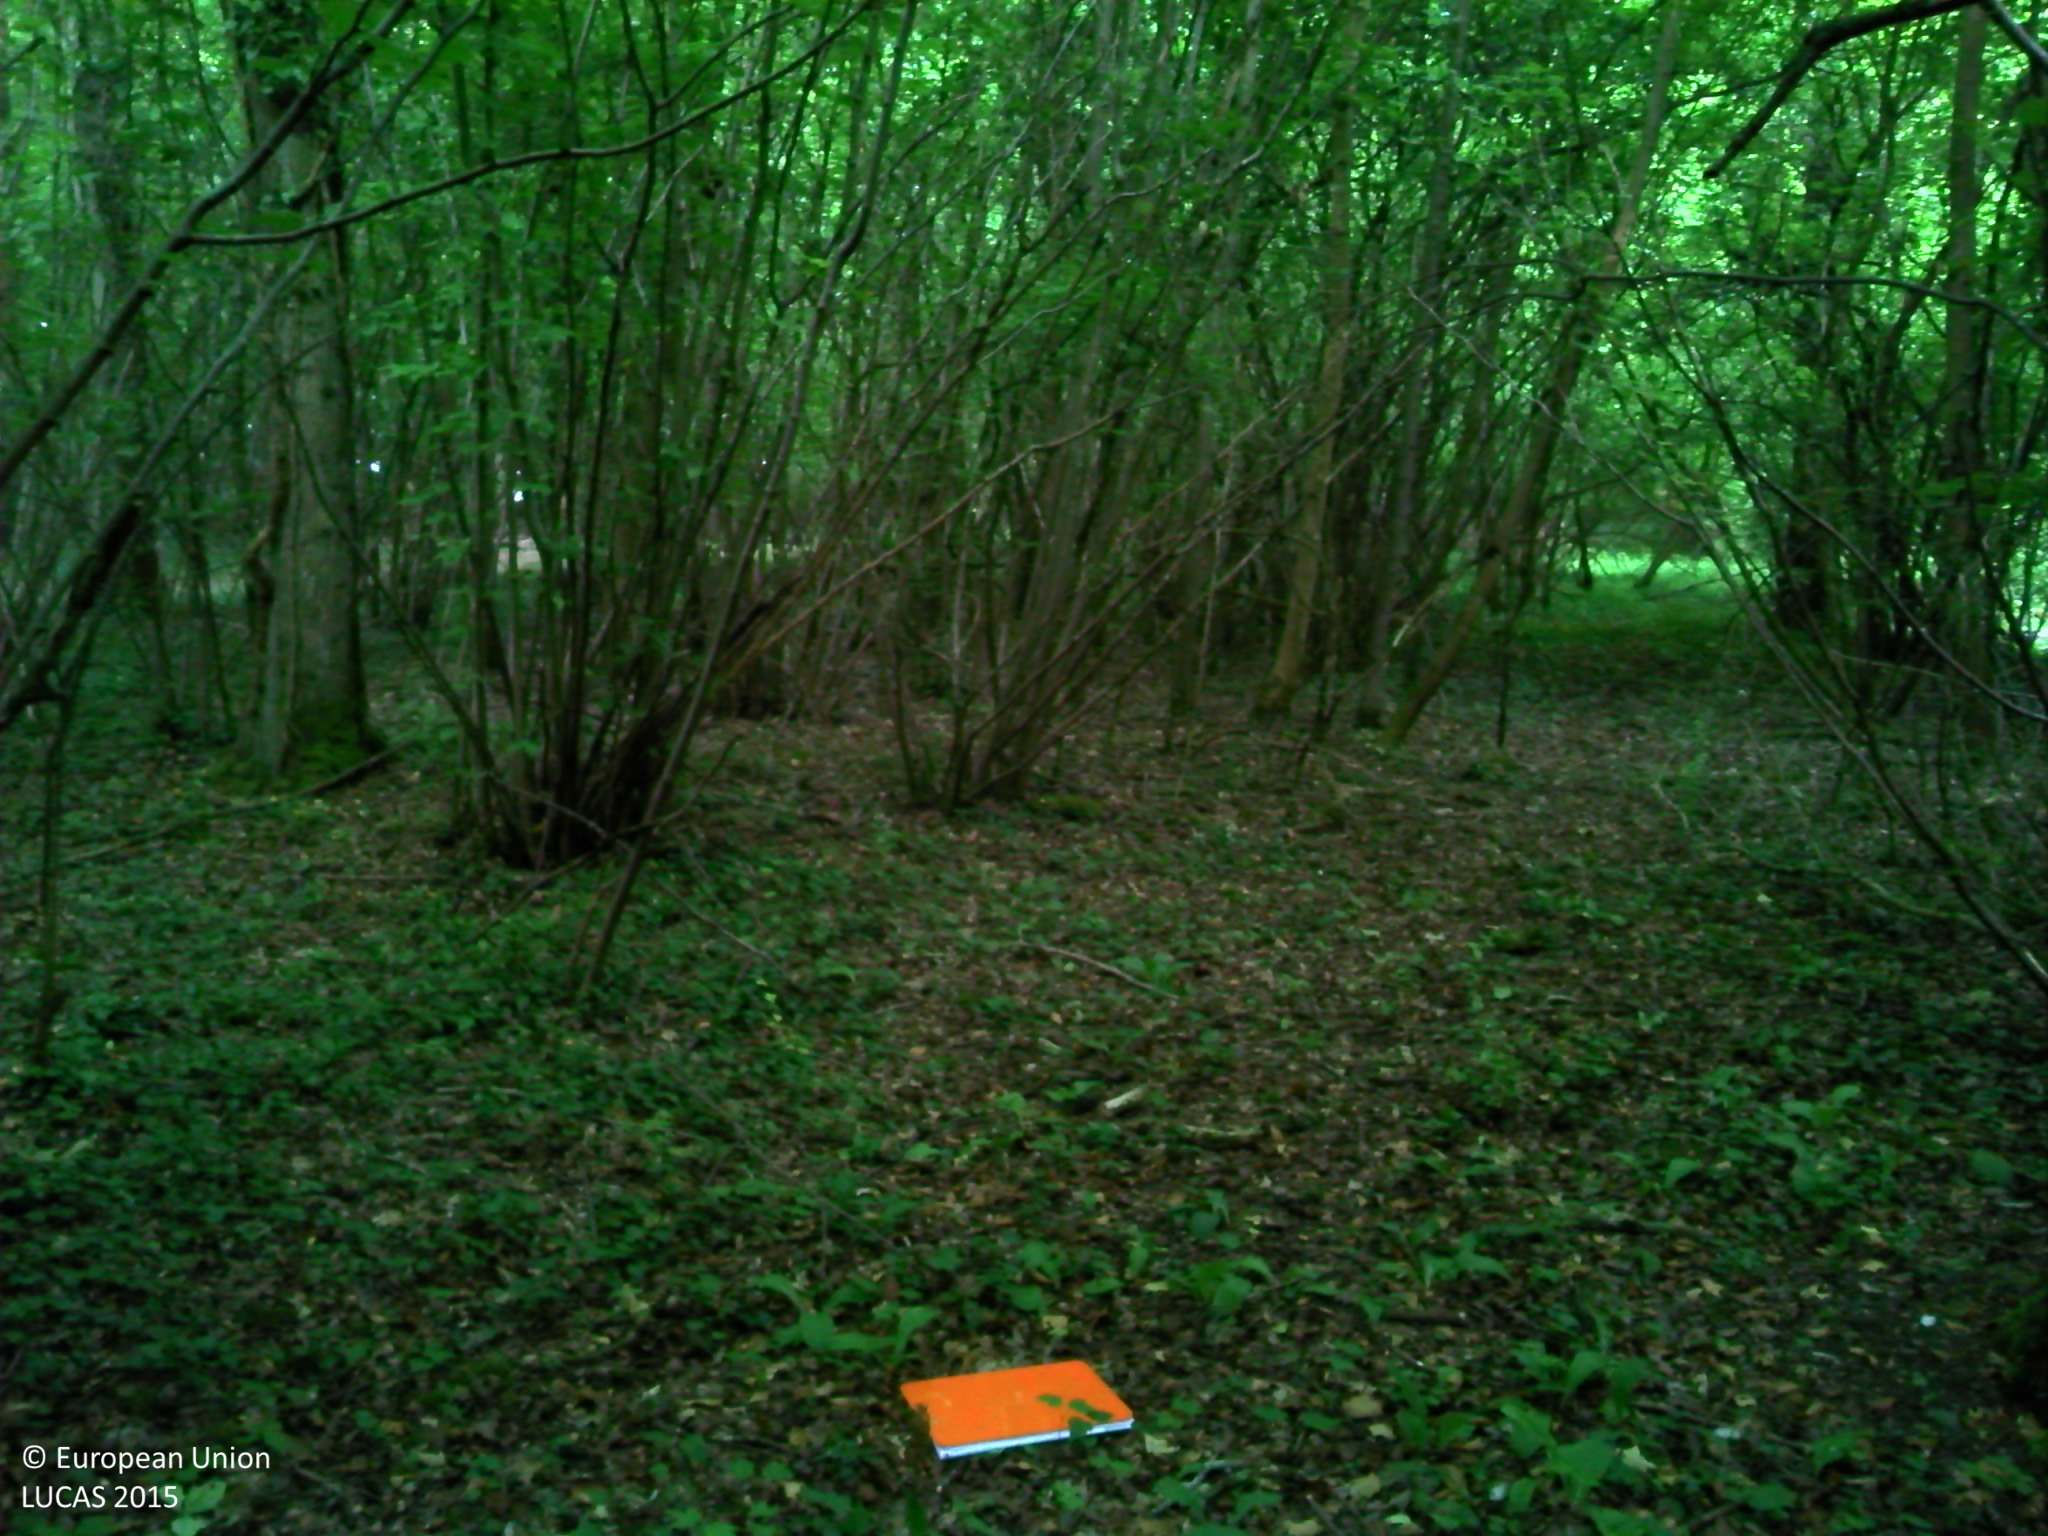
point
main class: Woodland
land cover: Broadleaved woodland
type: mesophytic deciduous forest
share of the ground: > 75 %
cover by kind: broadleaved forest trees 80 %, herbaceous plants 15 %, consolidated bare surface 5 %
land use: Forestry
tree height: > 5 m
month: June
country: FR
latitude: 49.2287
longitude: 1.2049
